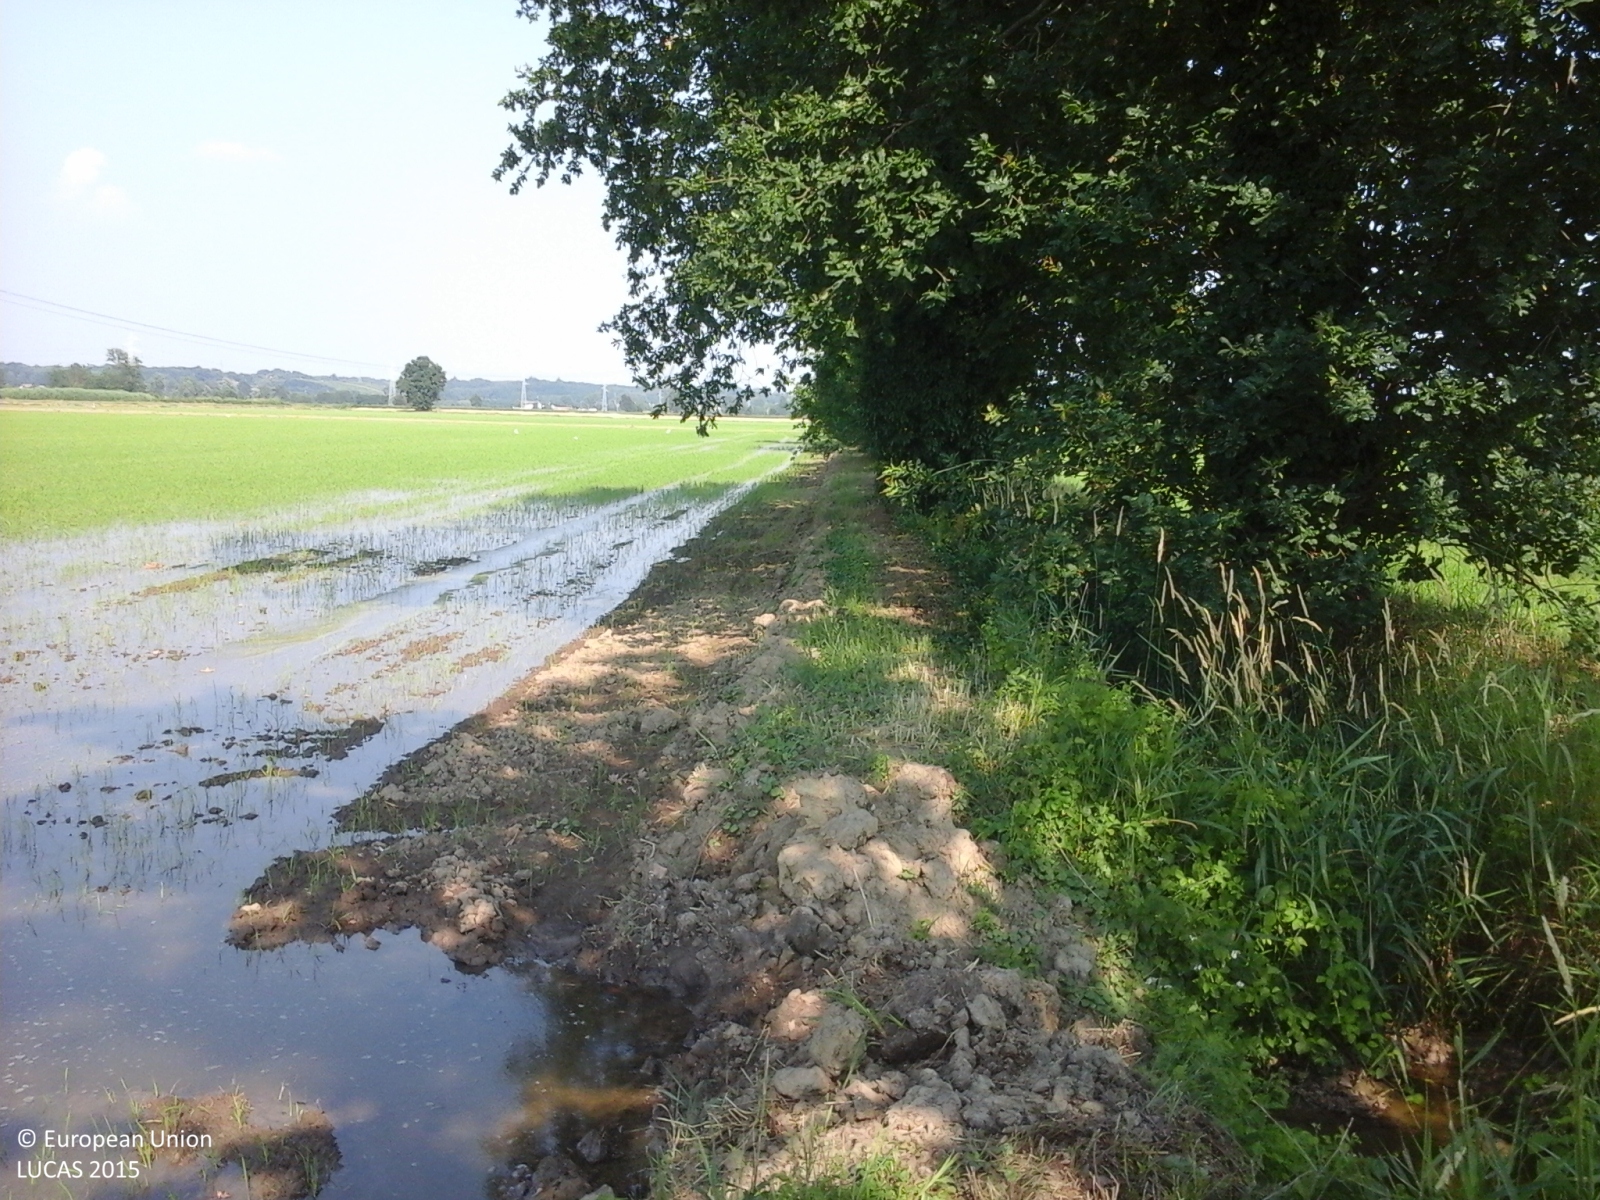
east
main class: Cropland
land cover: Rice
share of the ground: > 75 %
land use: Agriculture (excluding fallow land and kitchen gardens)
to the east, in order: Rice; Grass margins; Rice
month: June
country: IT
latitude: 45.1783
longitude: 9.4030
